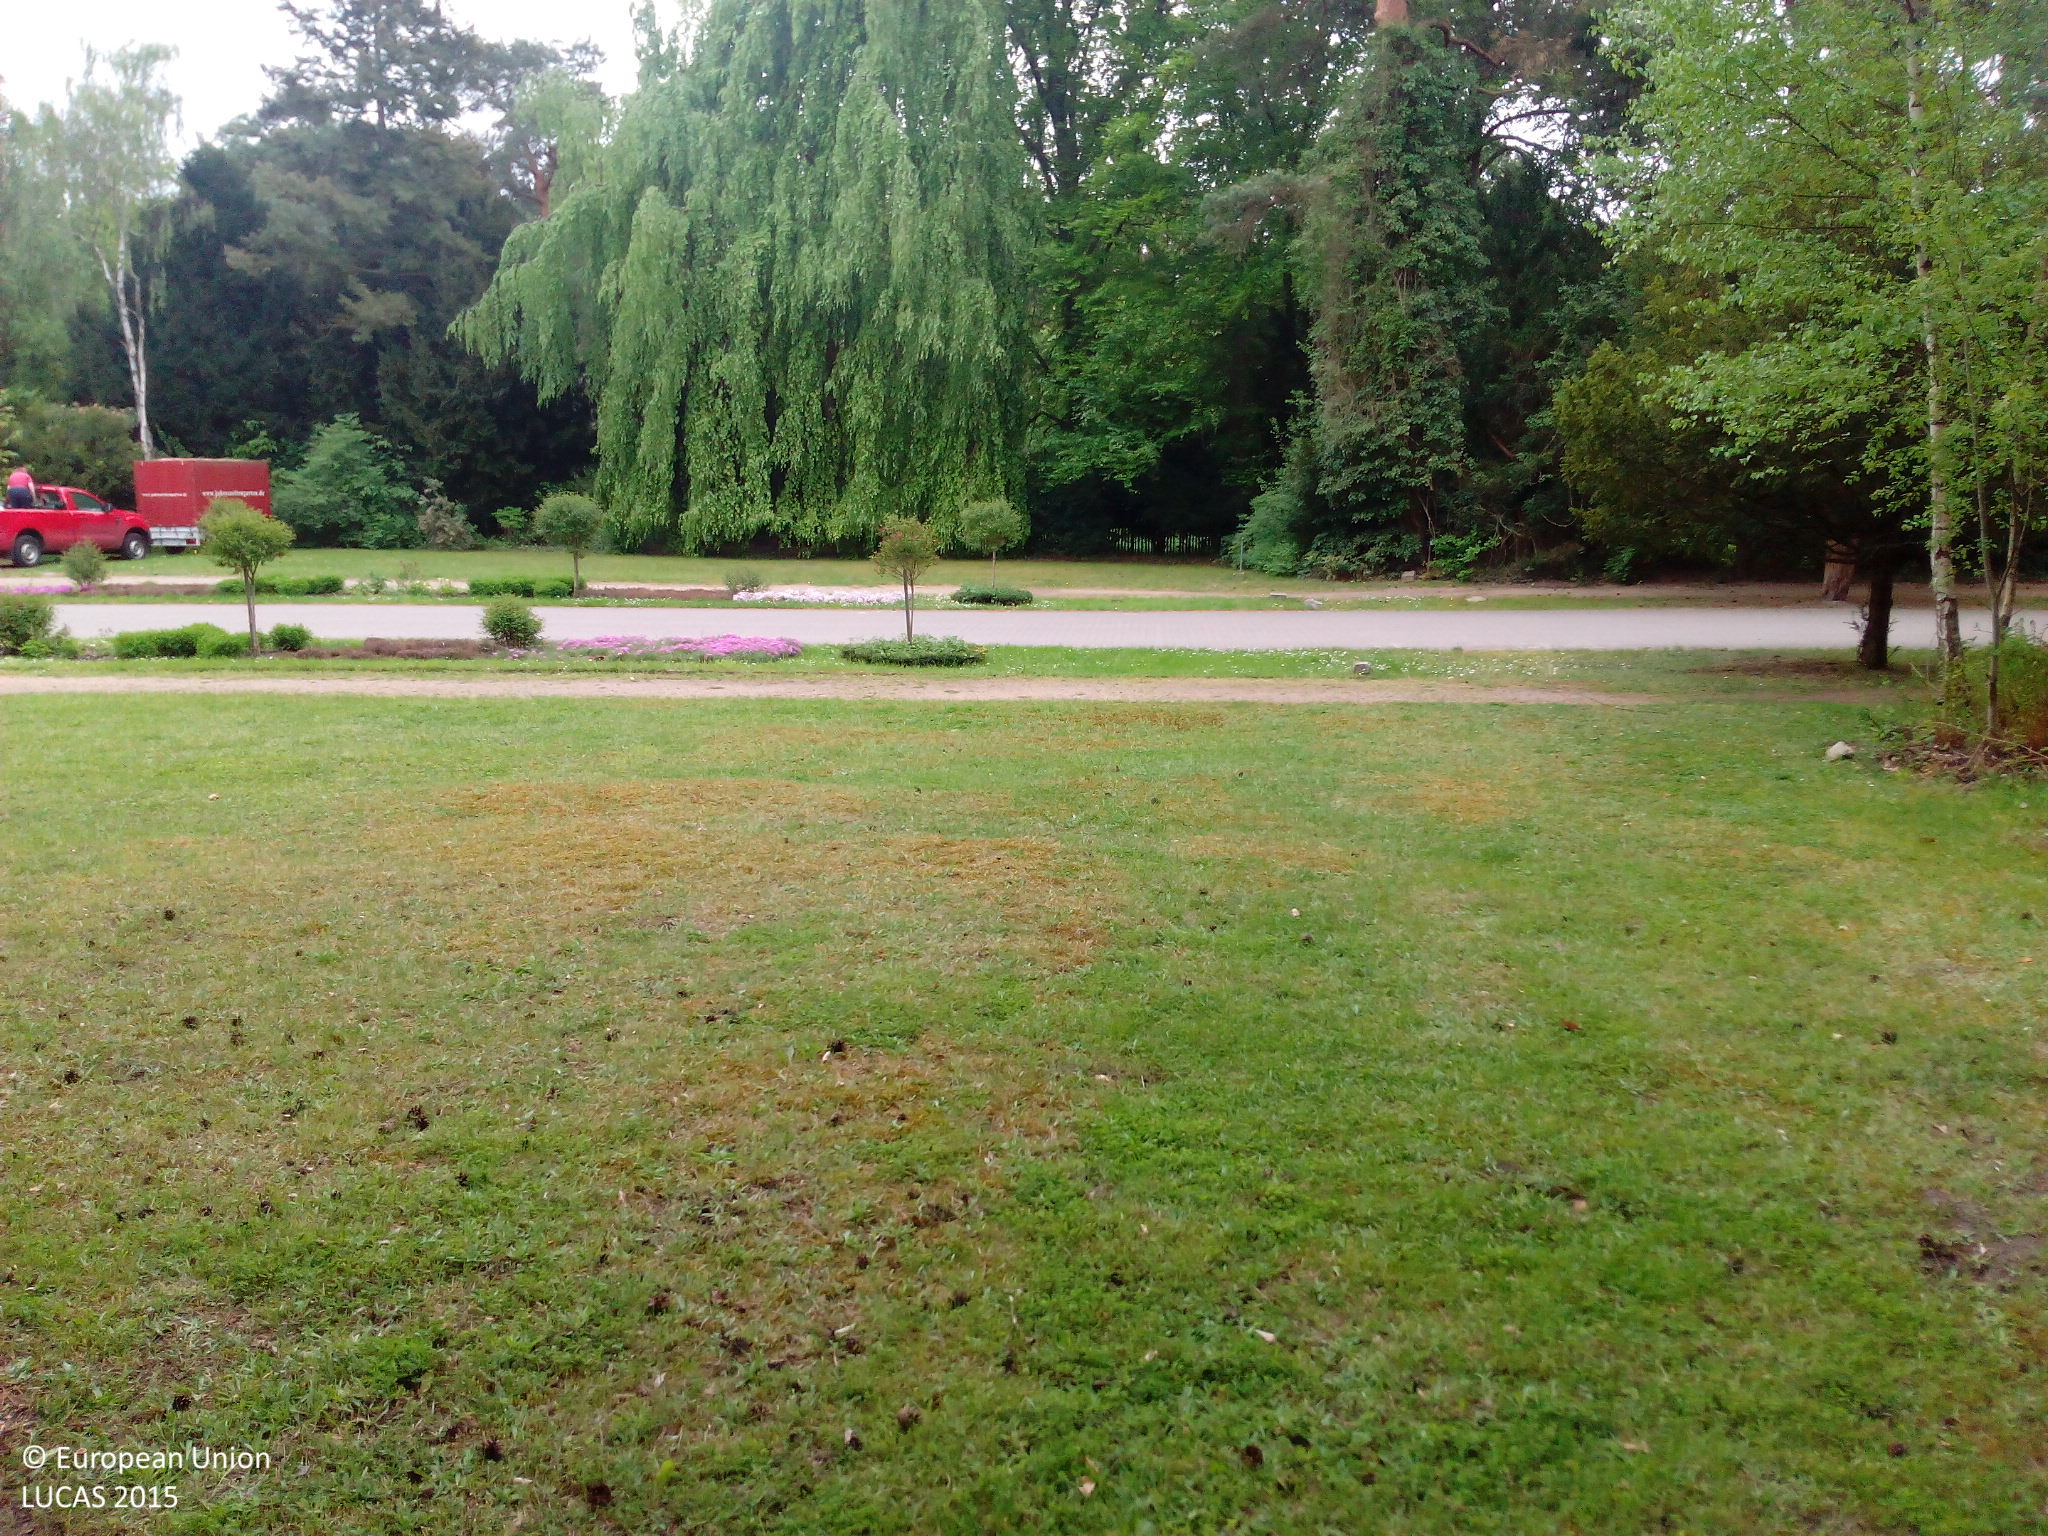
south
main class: Woodland
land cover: Broadleaved woodland
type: mesophytic deciduous forest
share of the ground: 50 - 75 %
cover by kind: broadleaved forest trees 60 %, shrubs 20 %, herbaceous plants 10 %, consolidated bare surface 10 %
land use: Community services
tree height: > 5 m
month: May
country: DE
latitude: 52.3887
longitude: 13.1885
